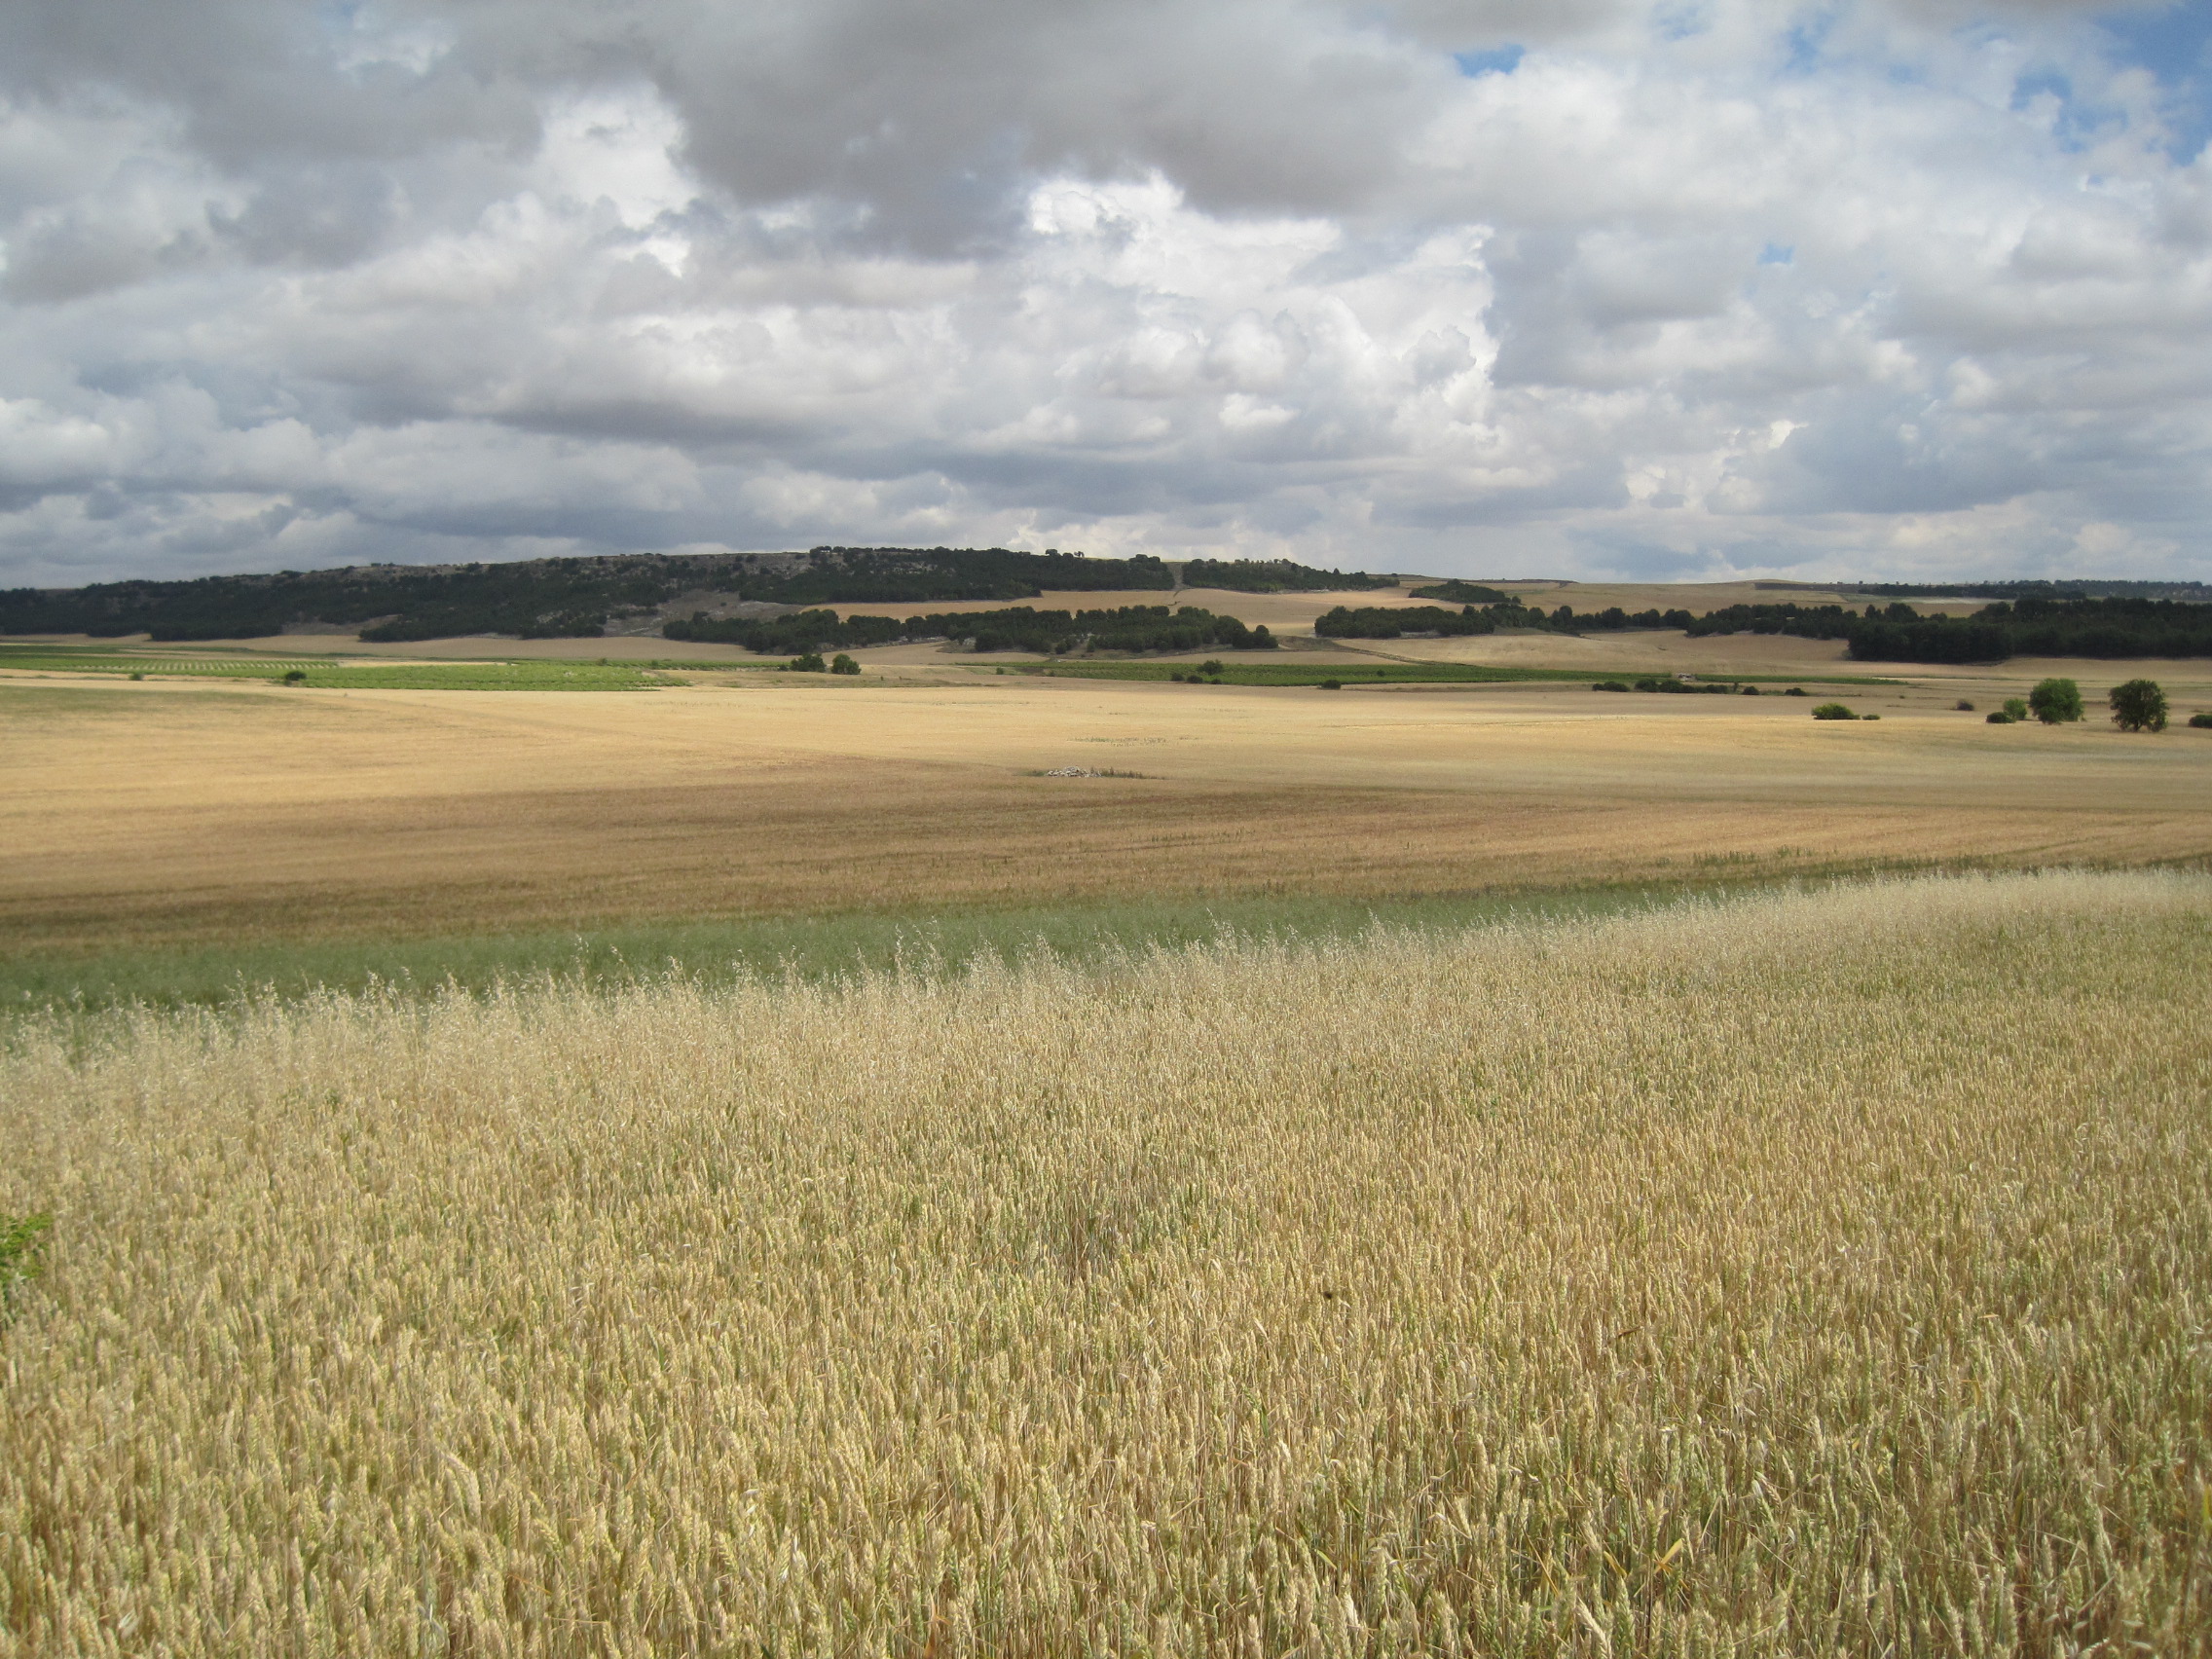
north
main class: Cropland
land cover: Common wheat
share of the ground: > 75 %
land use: Agriculture (excluding fallow land and kitchen gardens)
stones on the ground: 10 - 25 %
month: June
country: ES
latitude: 41.7747
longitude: -4.7115
